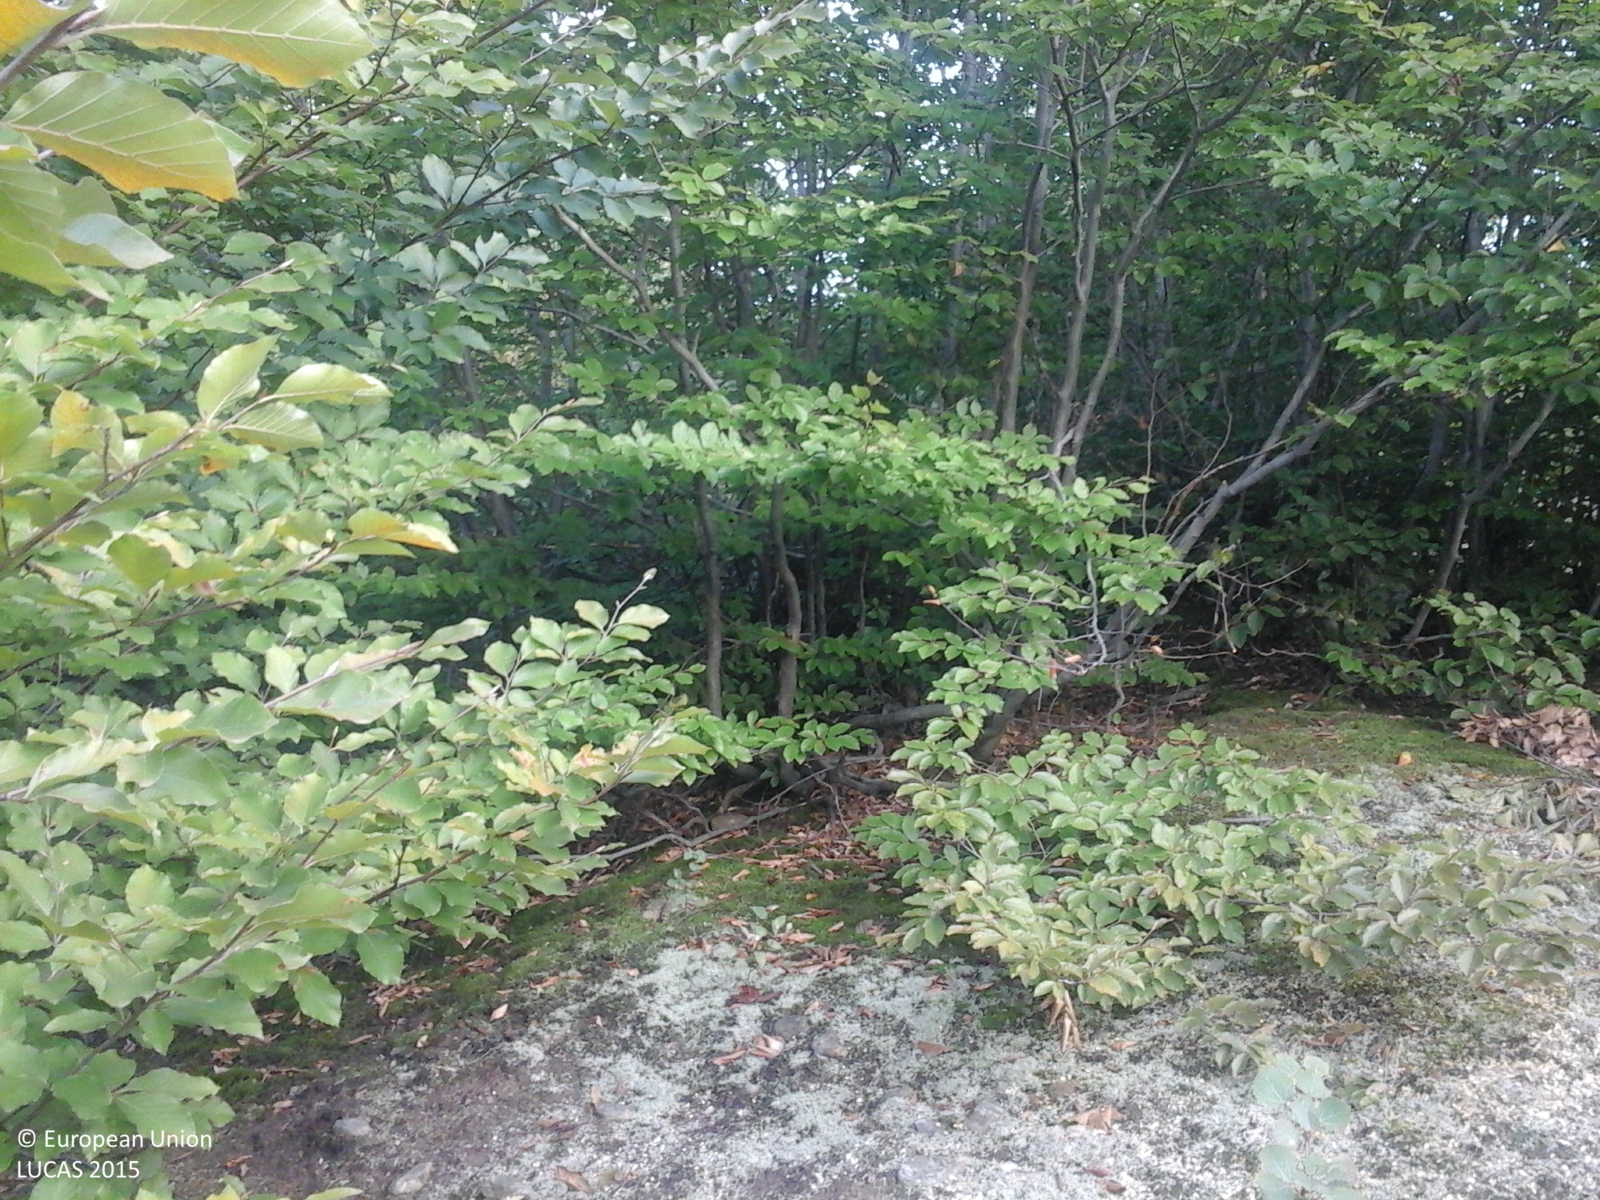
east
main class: Woodland
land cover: Broadleaved woodland
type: mesophytic deciduous forest
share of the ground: > 75 %
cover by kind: broadleaved forest trees 100 %
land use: Forestry
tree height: > 5 m
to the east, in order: Broadleaved woodland; Shrubland with sparse tree cover
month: September
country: RO
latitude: 45.0566
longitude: 23.6087
